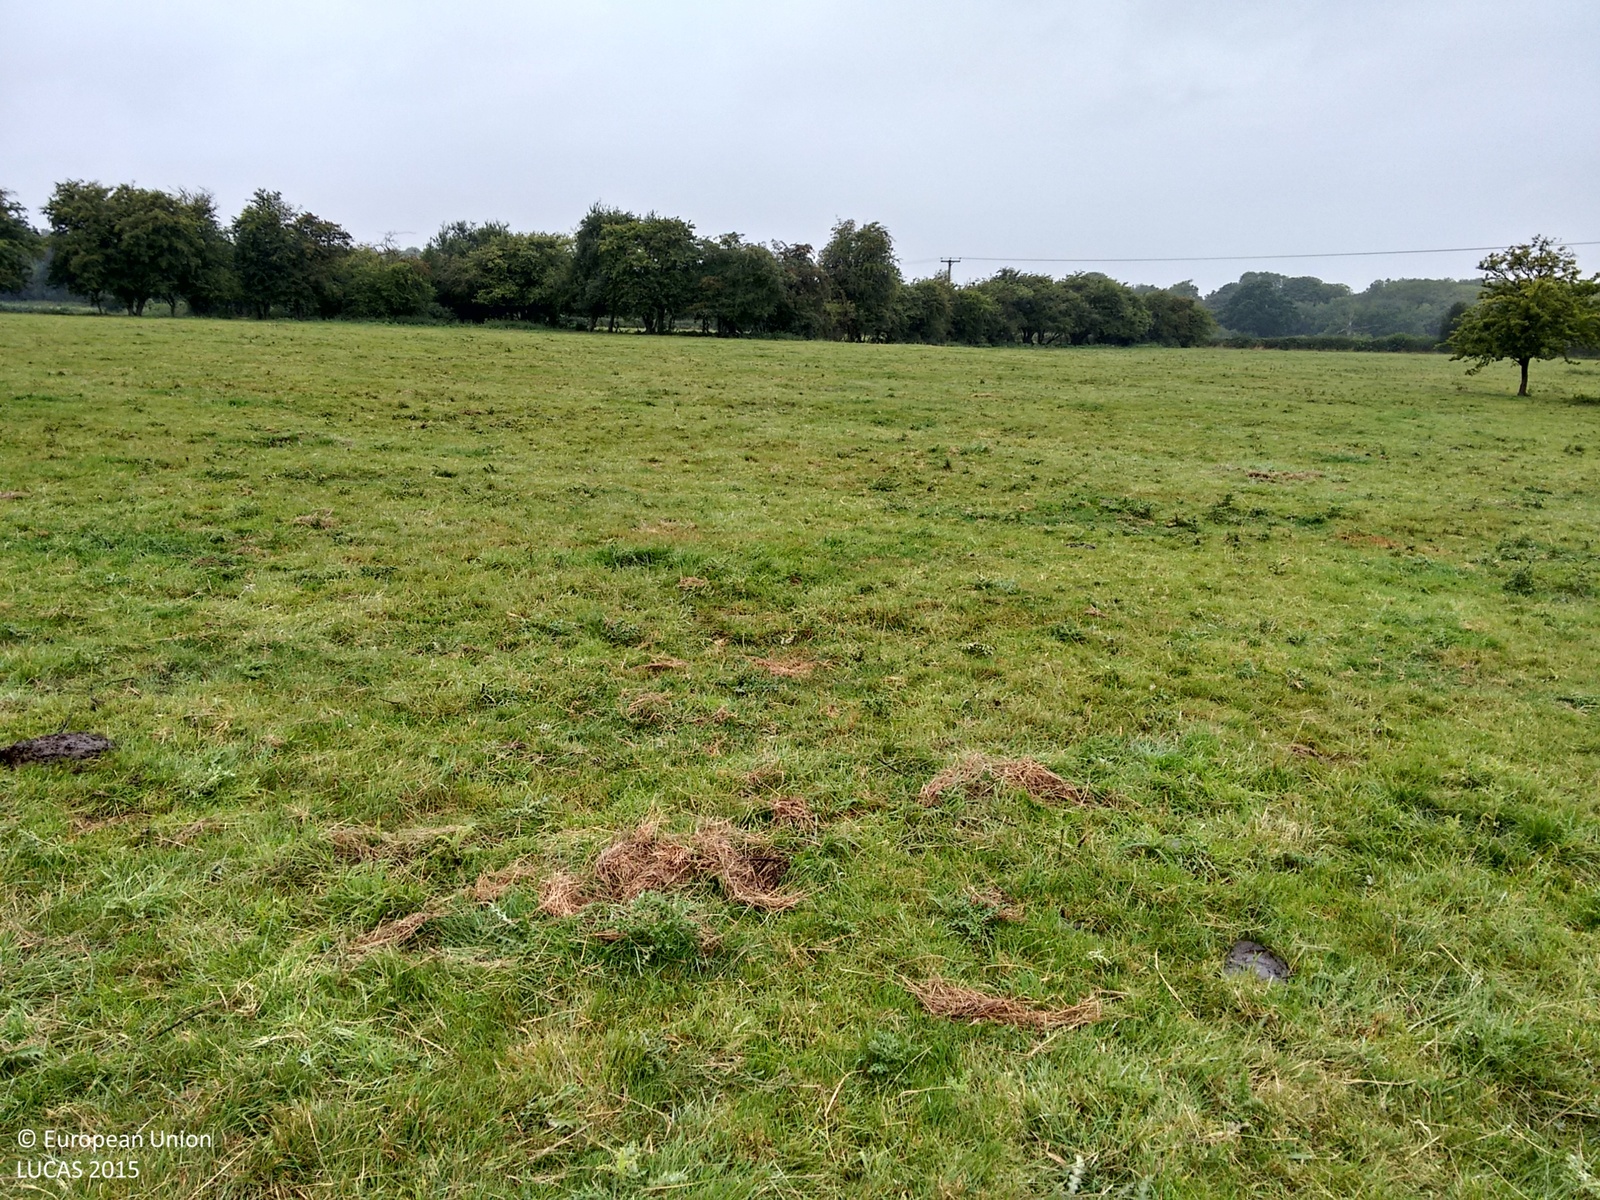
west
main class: Grassland
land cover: Grassland without tree/shrub cover
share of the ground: > 75 %
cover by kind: herbaceous plants 100 %
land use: Agriculture (excluding fallow land and kitchen gardens)
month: August
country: GB
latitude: 52.6273
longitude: -1.3805
